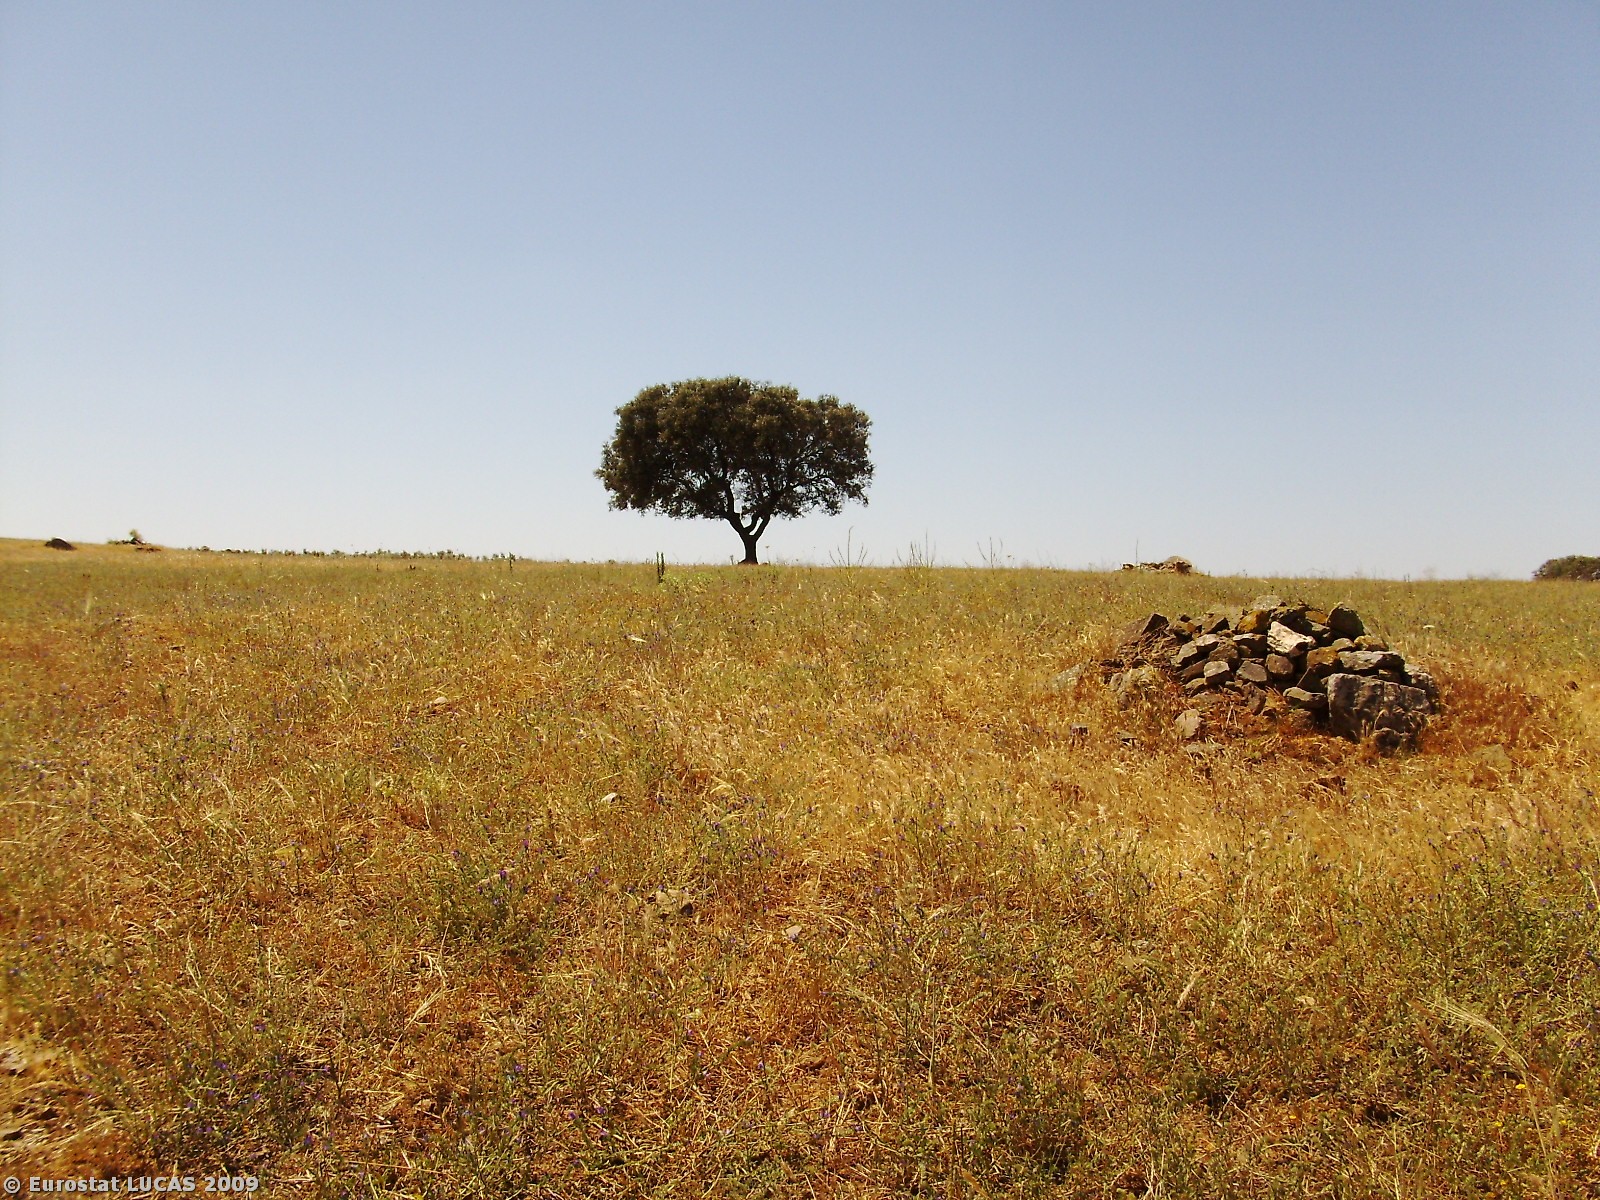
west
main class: Grassland
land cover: Spontaneously vegetated surfaces
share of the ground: > 75 %
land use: Fallow land
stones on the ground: 10 - 25 %
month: May
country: PT
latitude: 38.9084
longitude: -7.3653
